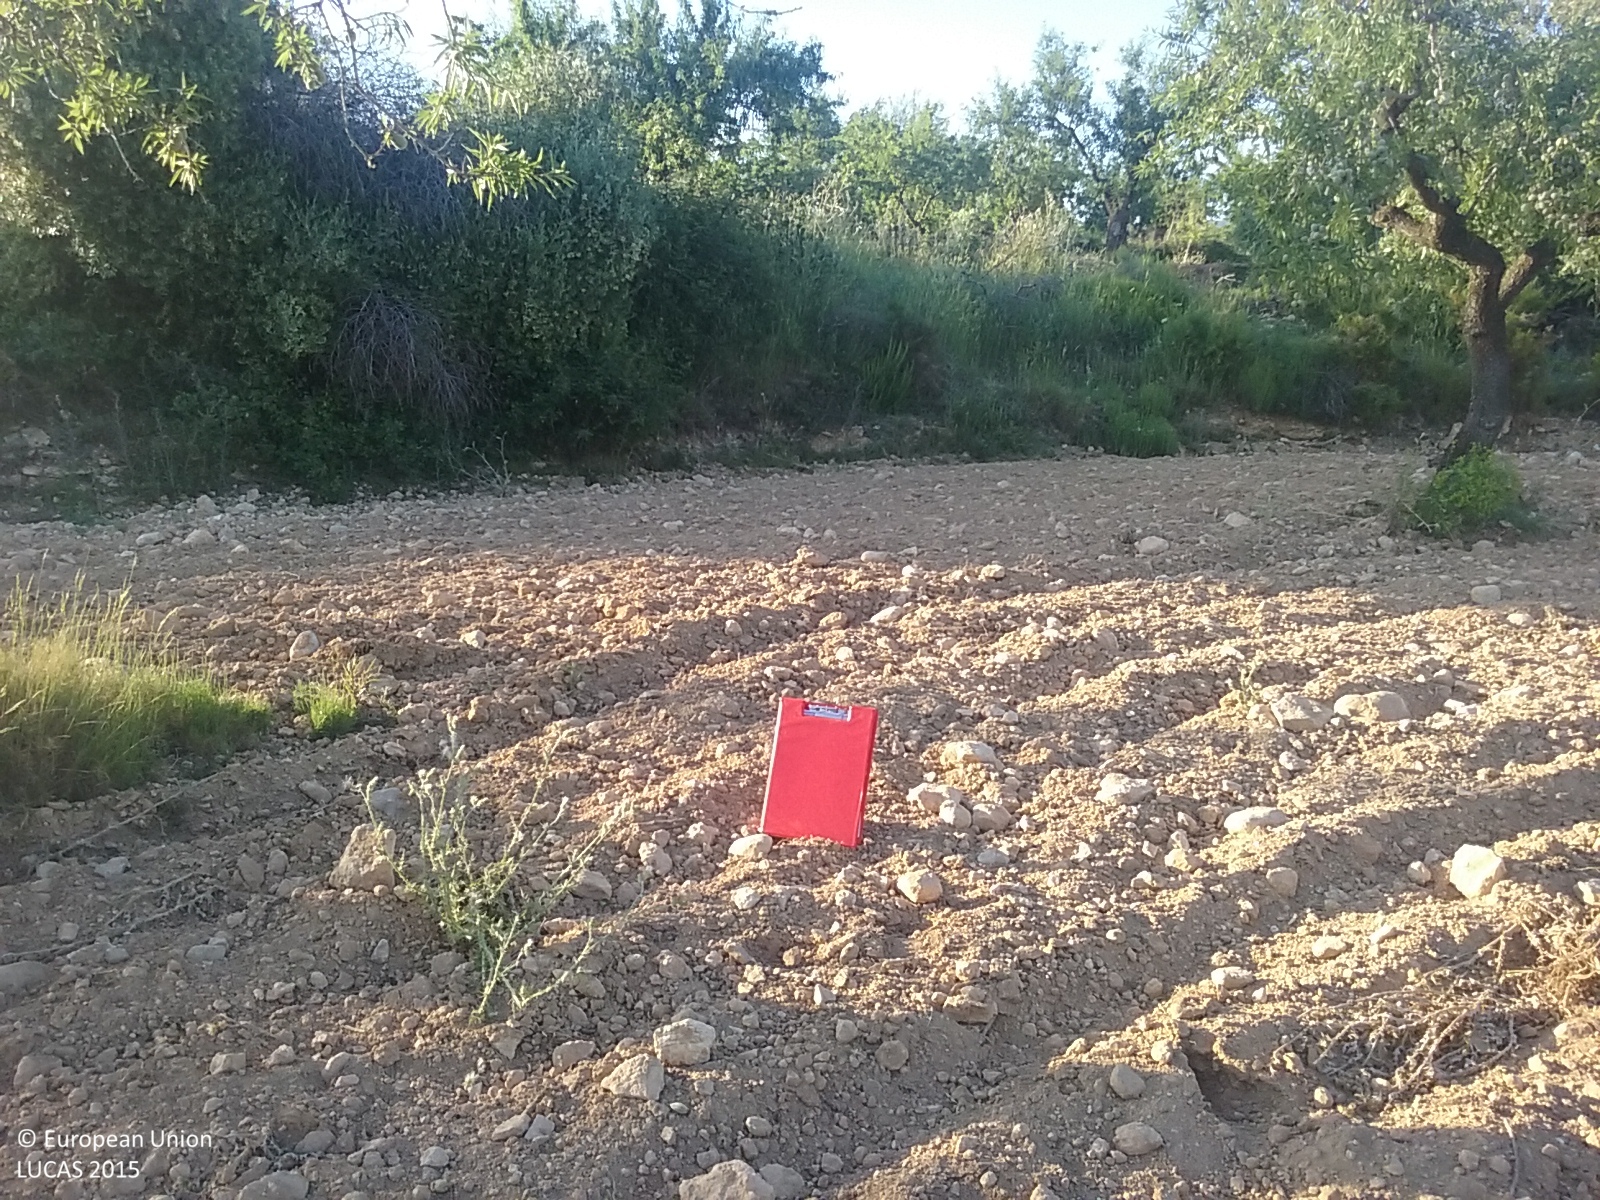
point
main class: Cropland
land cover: Nuts trees
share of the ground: 10 - 25 %
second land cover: Other bare soil
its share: > 75 %
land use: Agriculture (excluding fallow land and kitchen gardens)
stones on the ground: 10 - 25 %
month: May
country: ES
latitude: 40.2080
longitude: -0.0250
